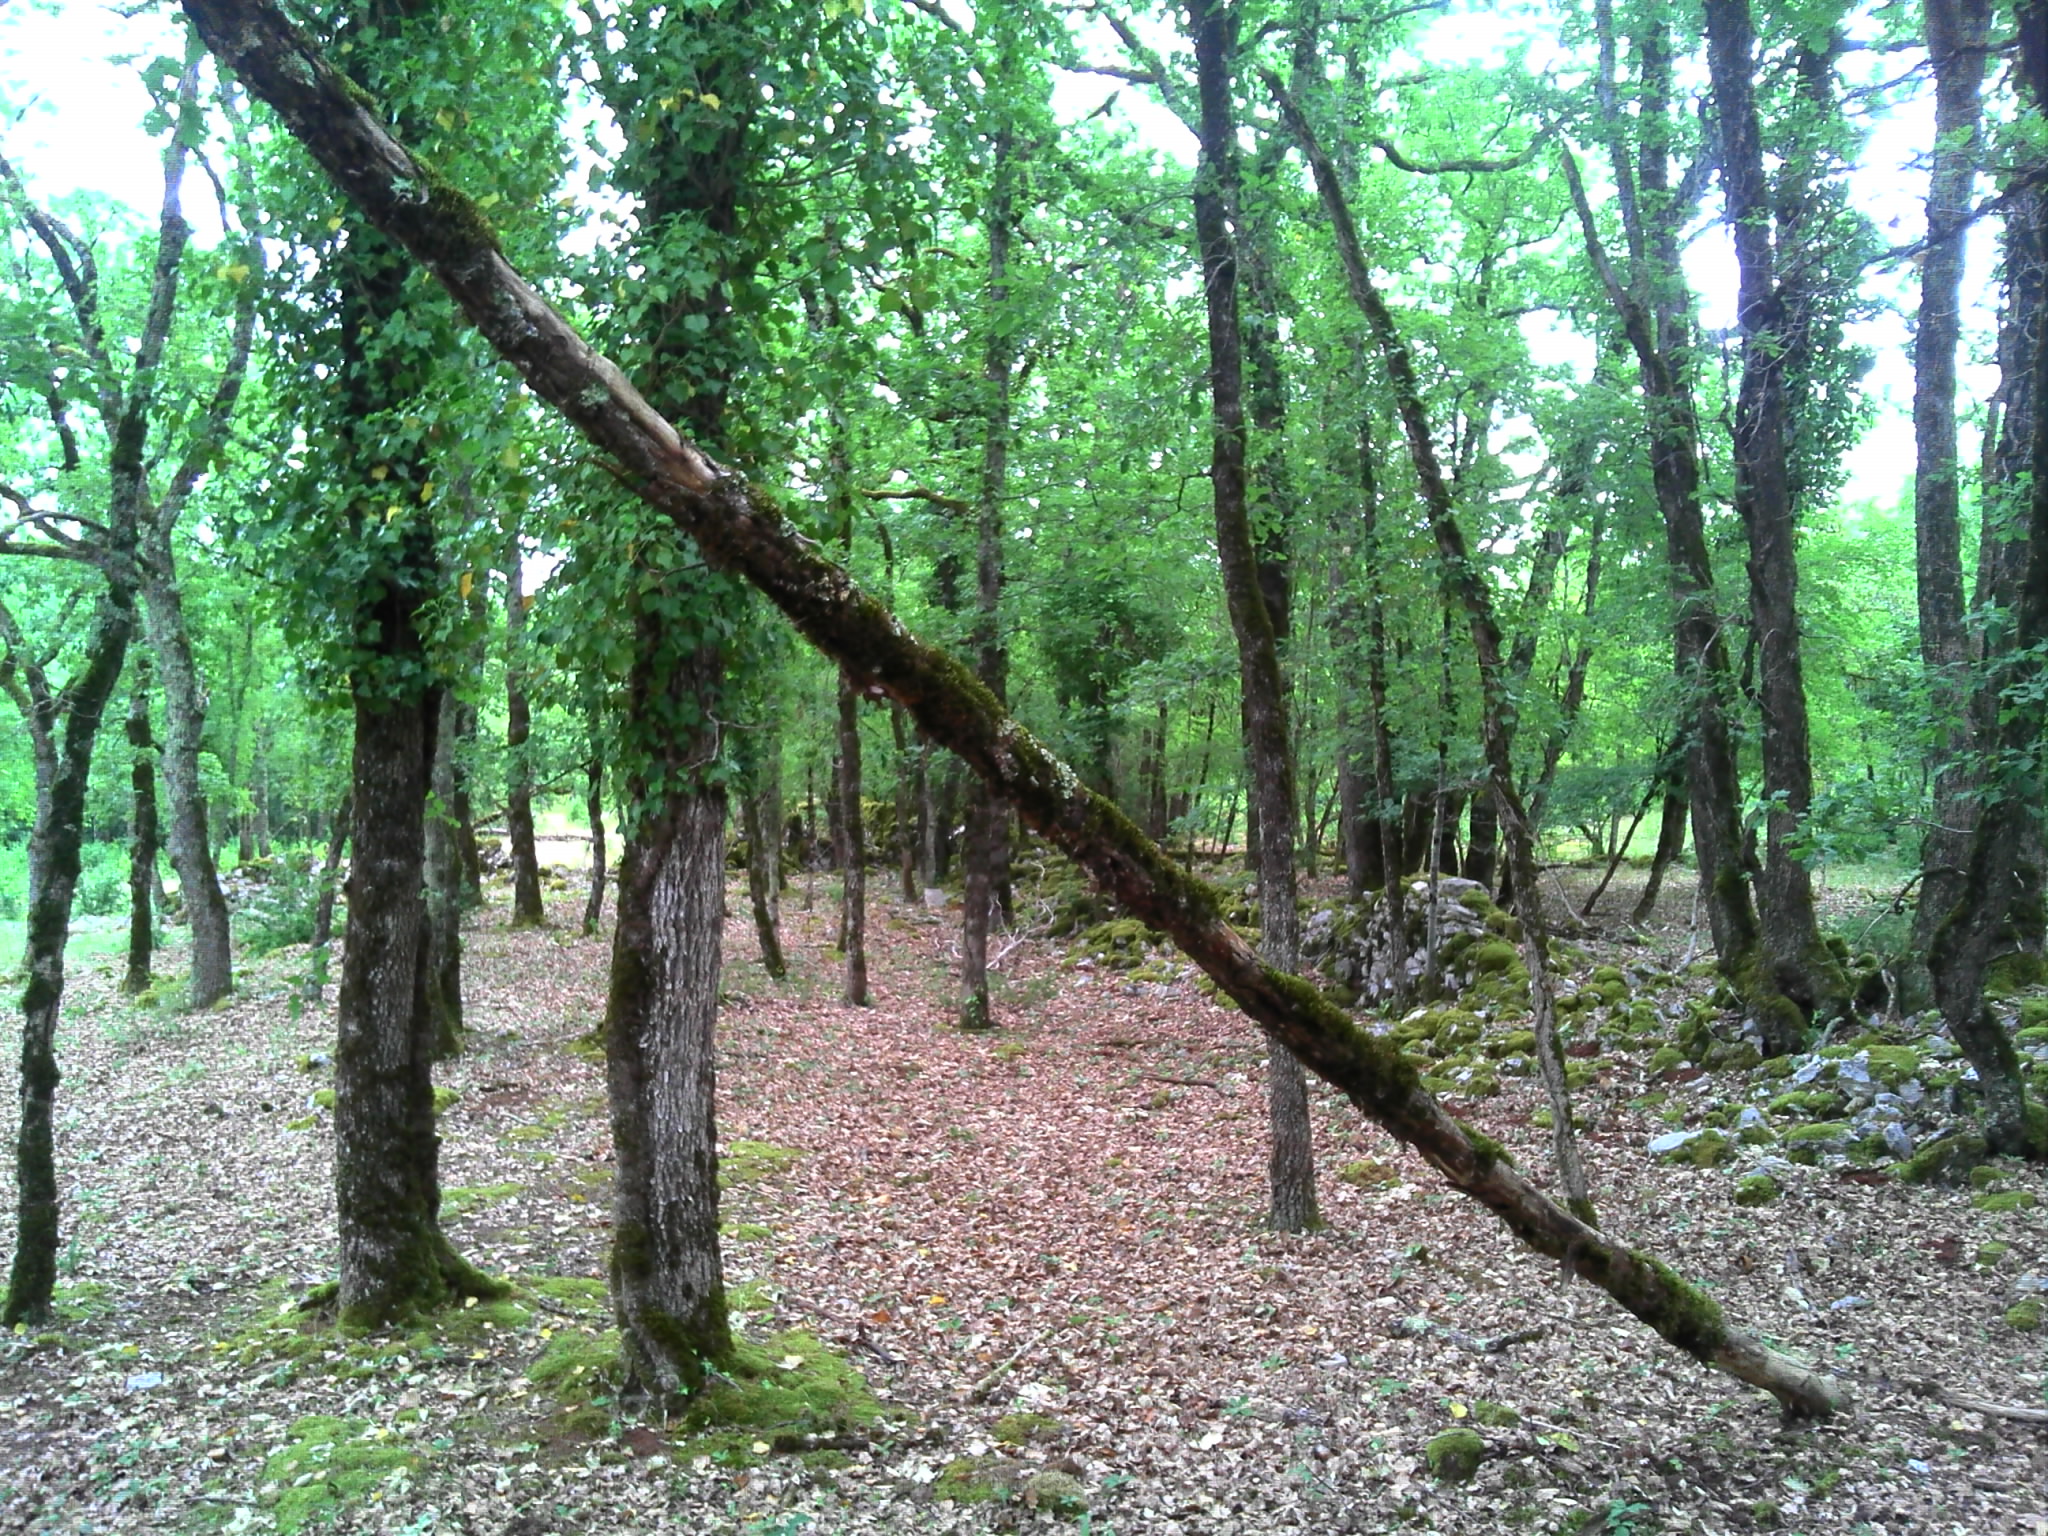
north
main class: Woodland
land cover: Broadleaved woodland
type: acidophilous oak and oak-birch forest
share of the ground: > 75 %
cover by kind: broadleaved forest trees 90 %, herbaceous plants 10 %
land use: Forestry
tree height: > 5 m
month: June
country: FR
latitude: 44.4440
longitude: 1.8202
